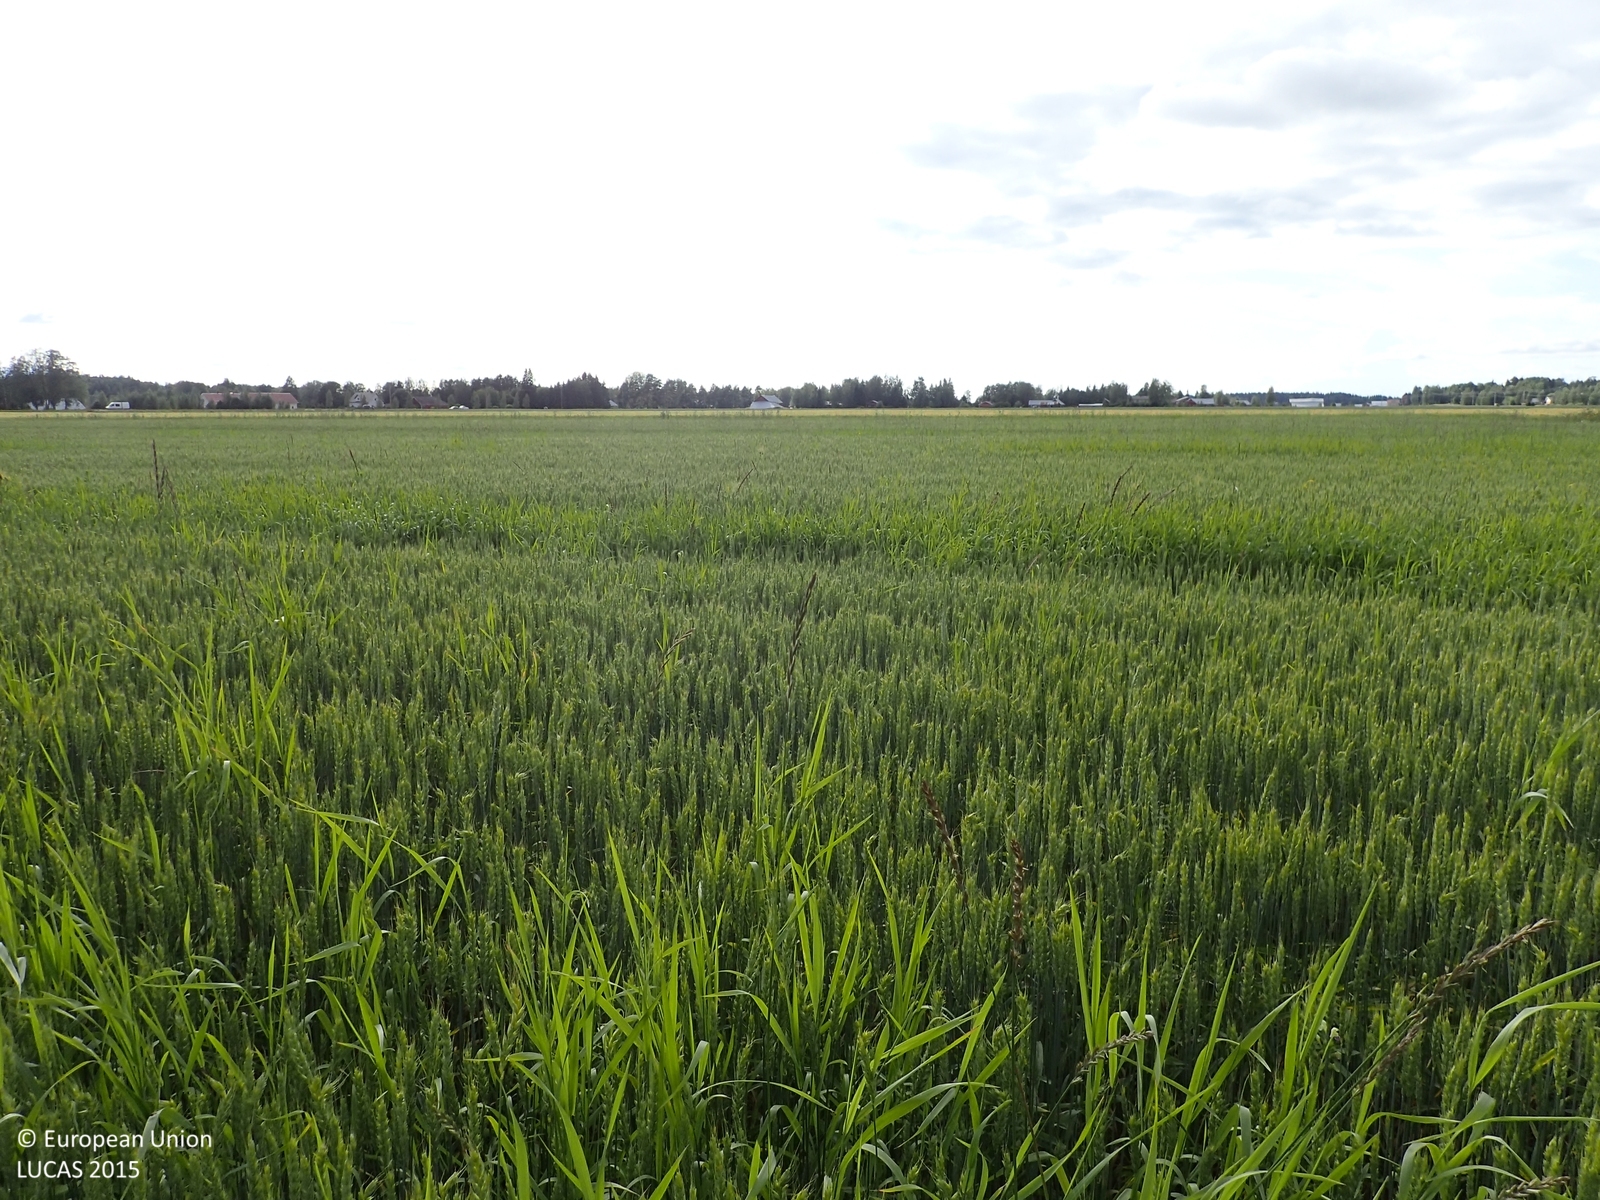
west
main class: Cropland
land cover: Common wheat
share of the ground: > 75 %
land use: Agriculture (excluding fallow land and kitchen gardens)
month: July
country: FI
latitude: 62.9909
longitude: 21.9863
